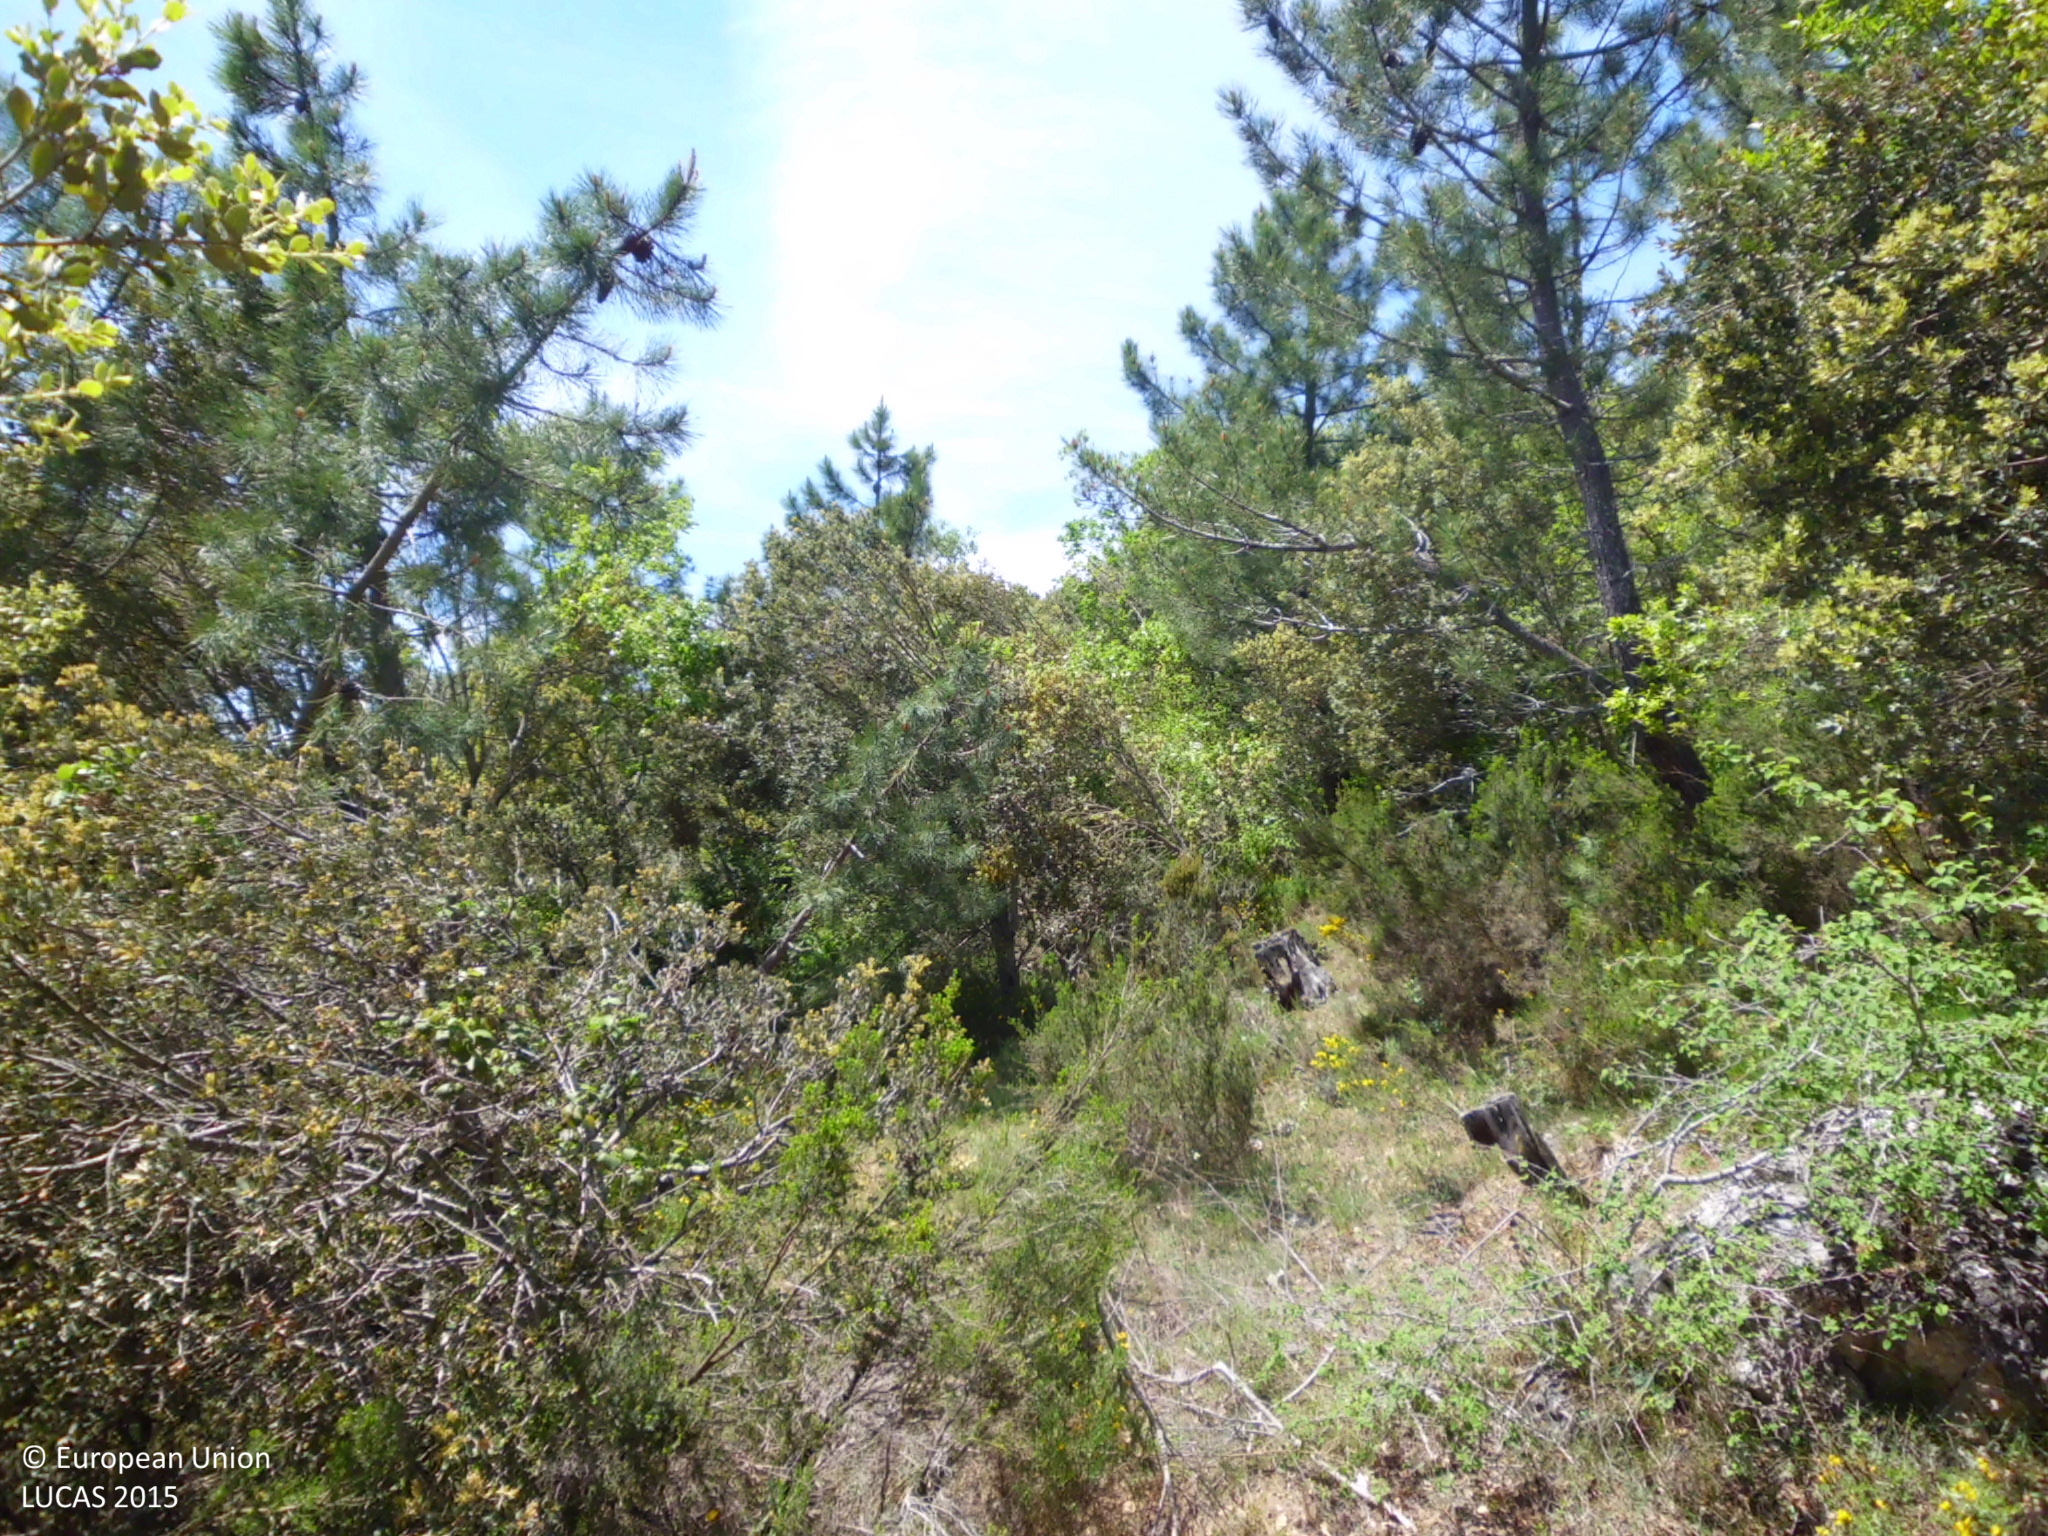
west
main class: Woodland
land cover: Pine dominated coniferous woodland
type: coniferous forest of the mediterranean region
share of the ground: > 75 %
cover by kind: coniferous forest trees 65 %, broadleaved forest trees 15 %, shrubs 10 %, herbaceous plants 10 %
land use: Semi-natural and natural areas not in use
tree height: > 5 m
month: May
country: ES
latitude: 42.7558
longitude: -3.4650
